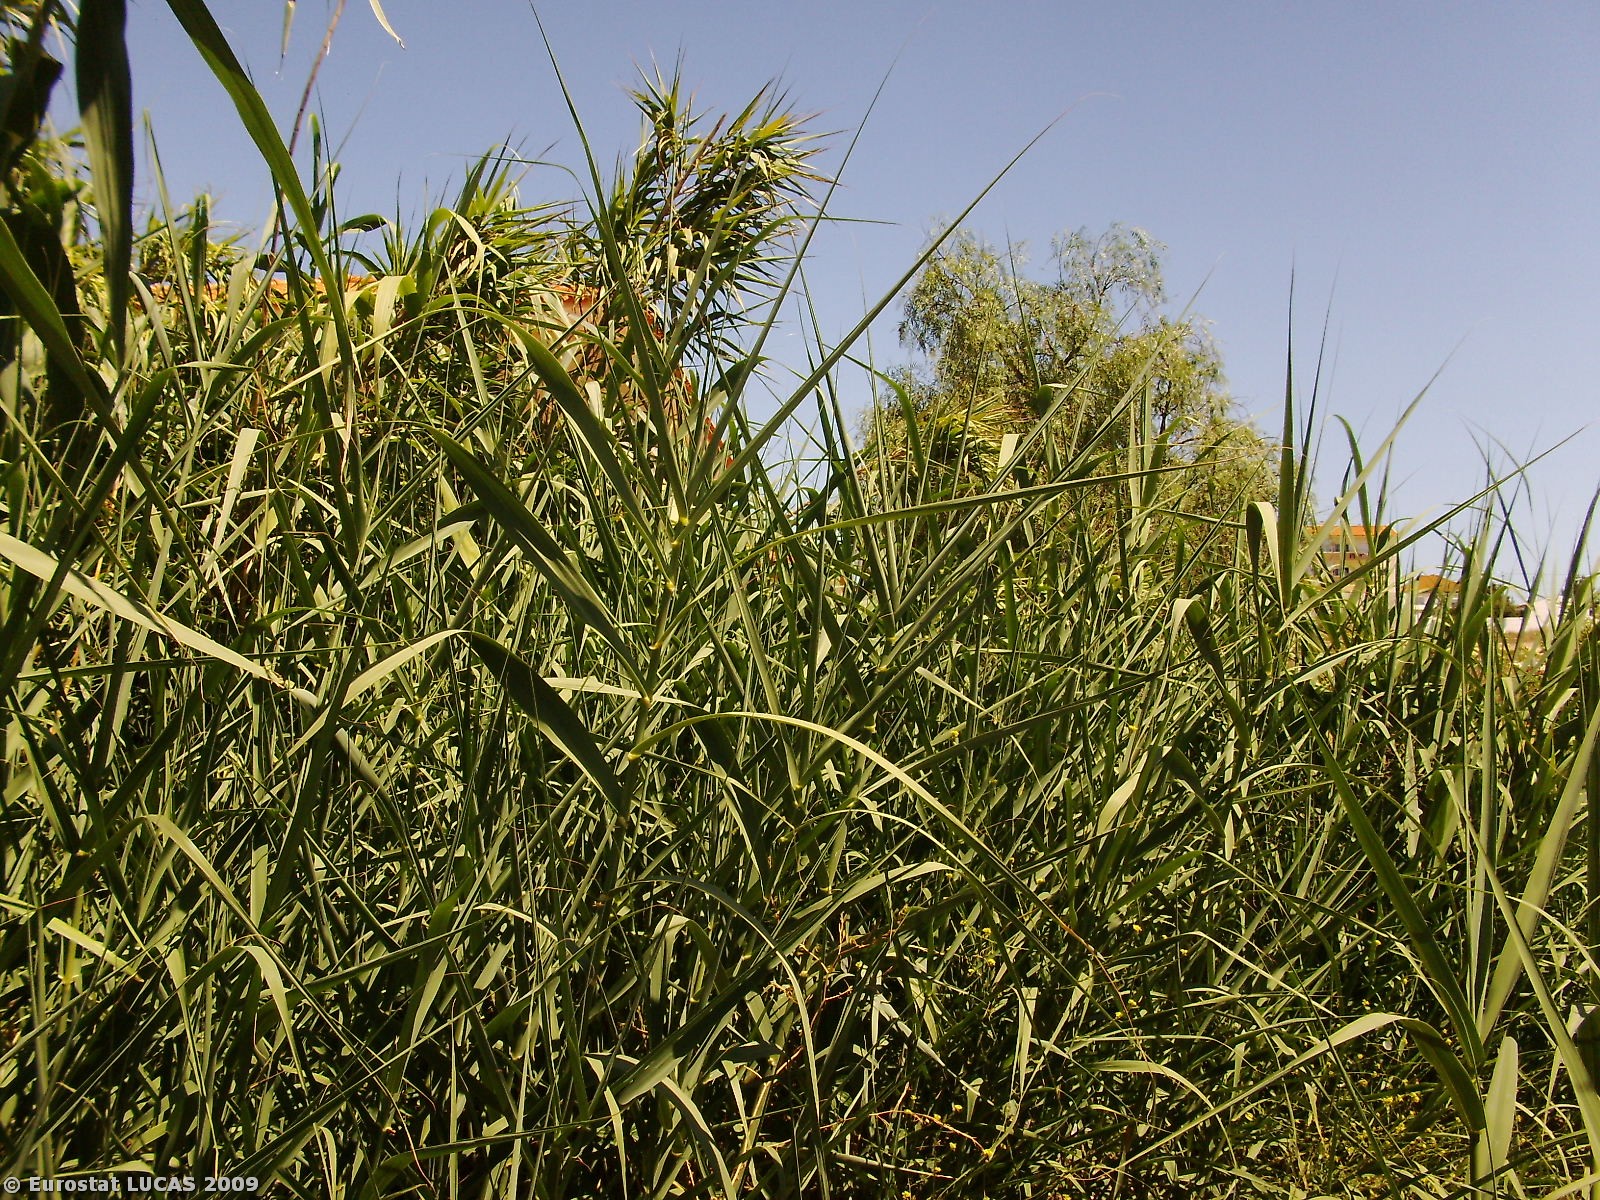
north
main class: Shrubland
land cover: Shrubland without tree cover
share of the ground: > 75 %
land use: Fallow land
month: July
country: PT
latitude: 39.3997
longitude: -9.1448
